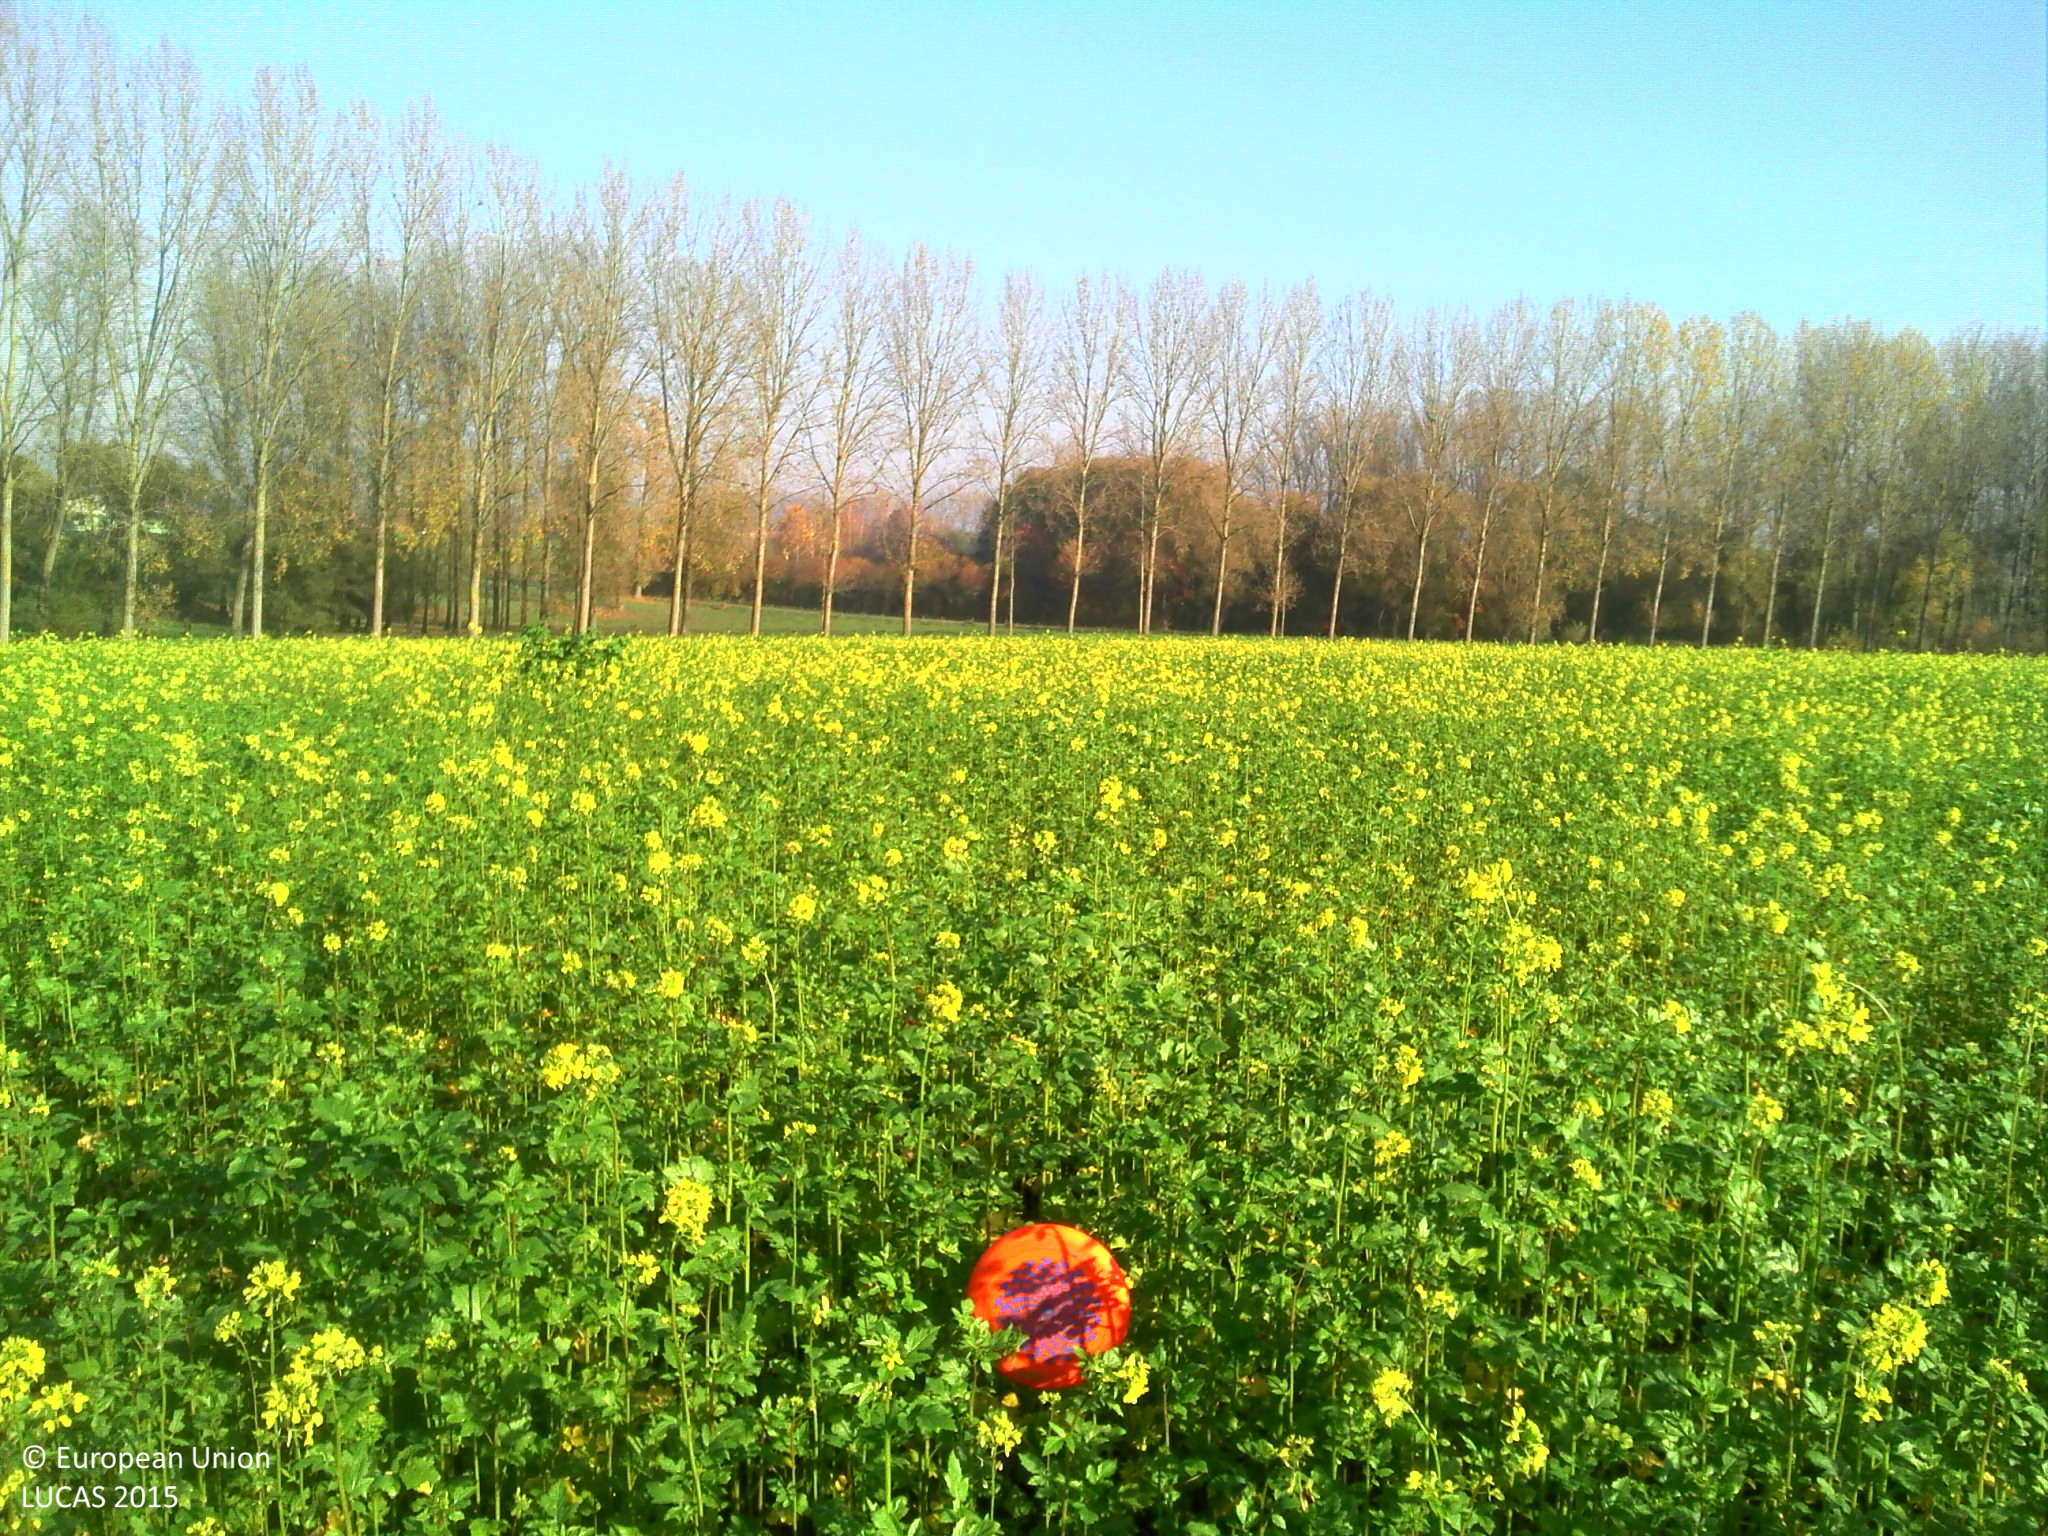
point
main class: Cropland
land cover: Other fibre and oleaginous crops
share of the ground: > 75 %
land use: Agriculture (excluding fallow land and kitchen gardens)
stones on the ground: < 10 %
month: November
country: BE
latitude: 50.7504
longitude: 4.0556
